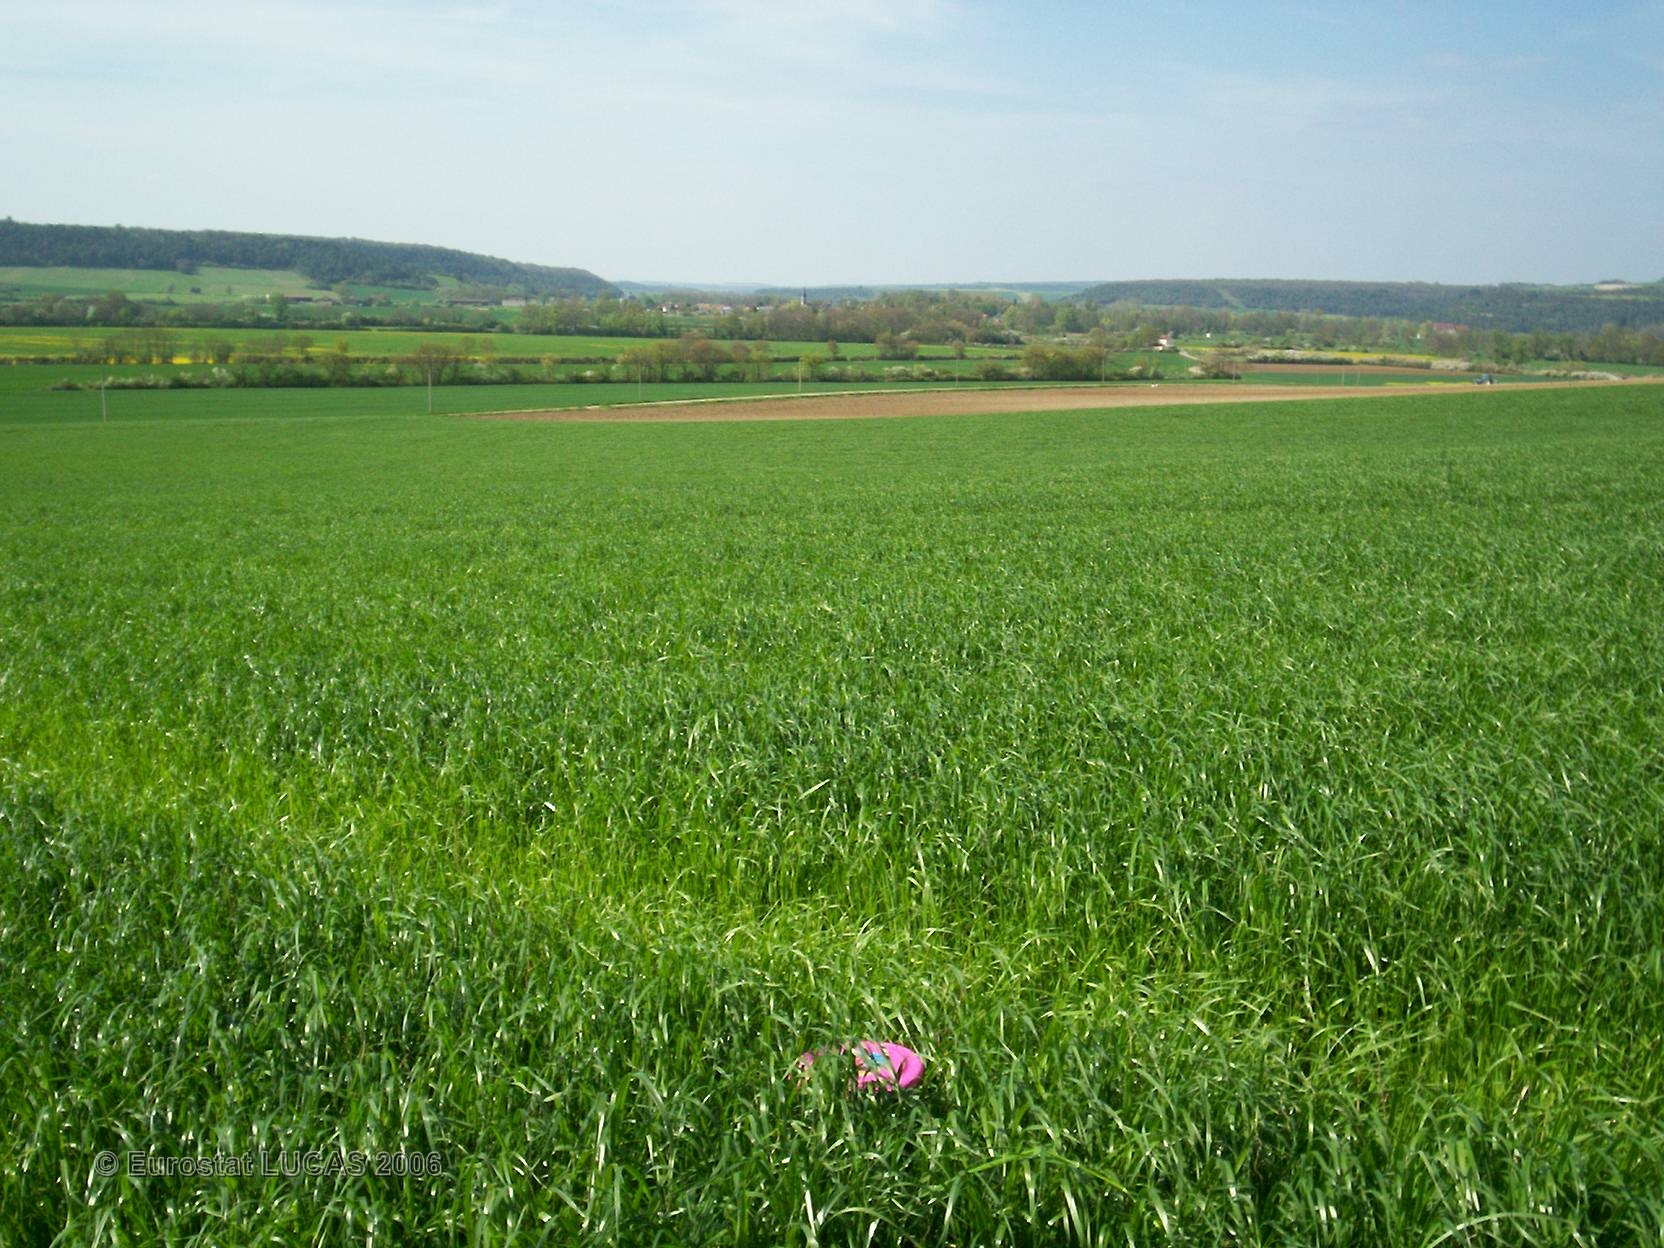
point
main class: Cropland
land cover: Barley
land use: Agriculture (excluding fallow land and kitchen gardens)
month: April
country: FR
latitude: 47.9072
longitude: 4.5264
